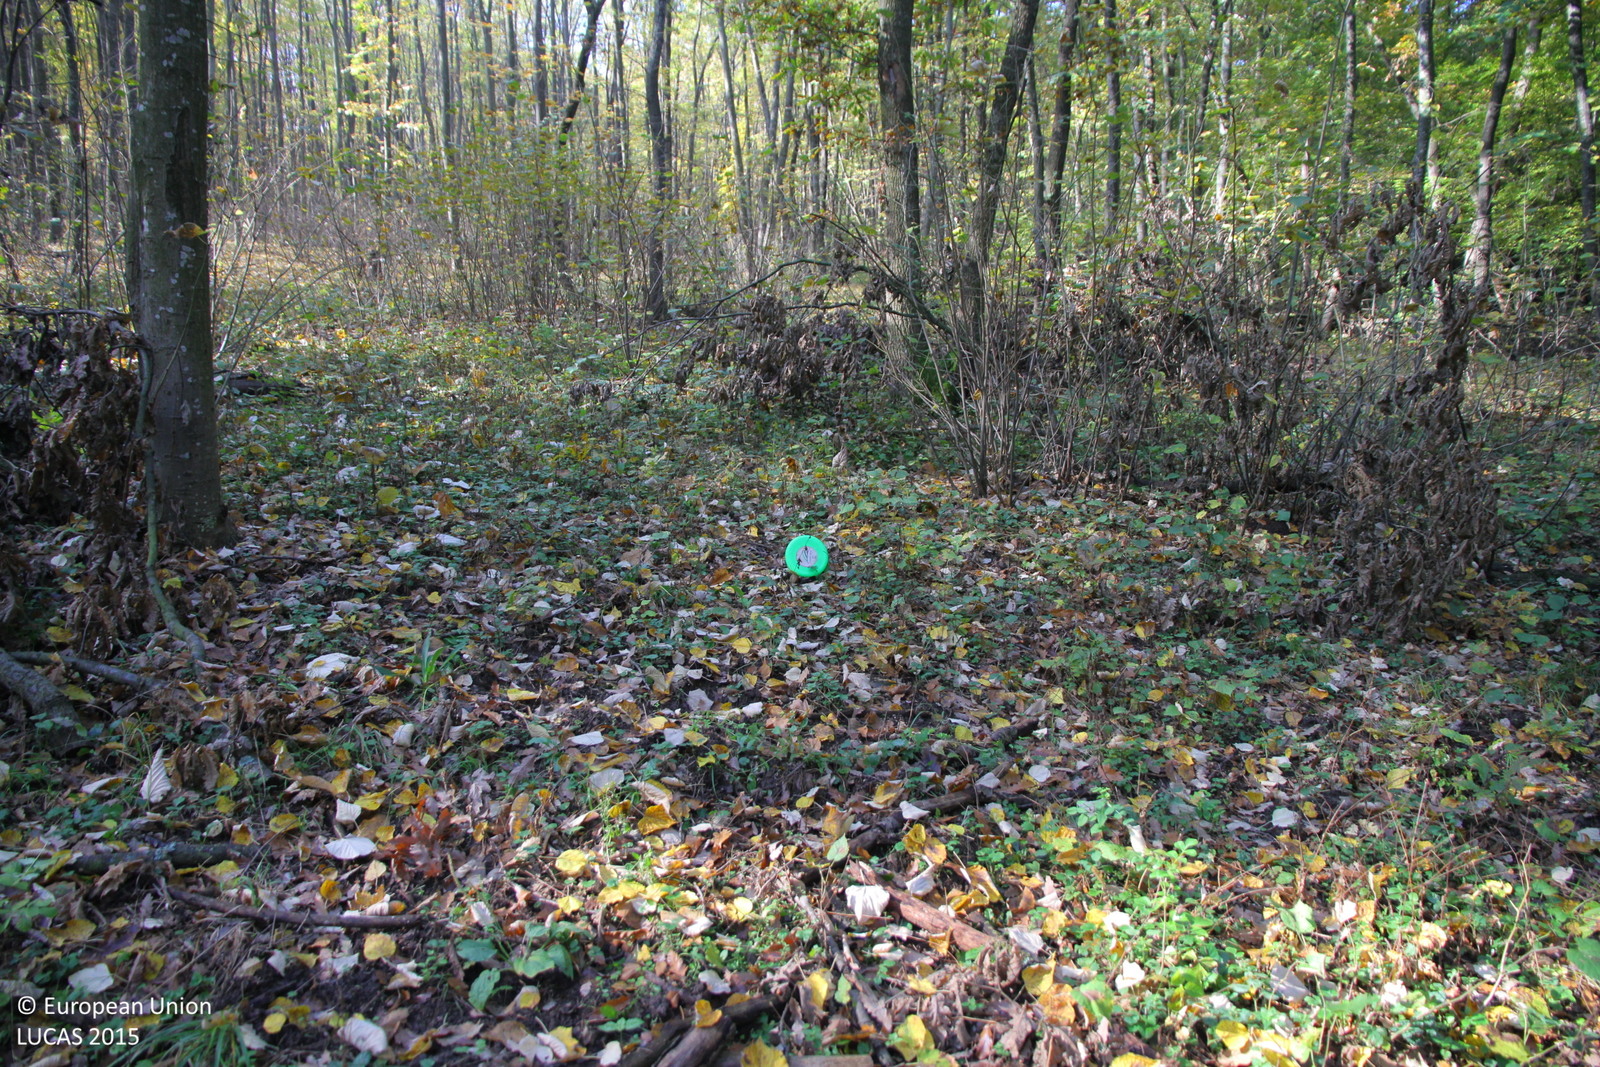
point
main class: Woodland
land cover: Broadleaved woodland
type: beech forest
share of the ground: > 75 %
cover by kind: broadleaved forest trees 90 %, herbaceous plants 5 %, unconsolidated bare surface 5 %
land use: Forestry
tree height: > 5 m
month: October
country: BG
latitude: 43.8708
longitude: 26.3443
